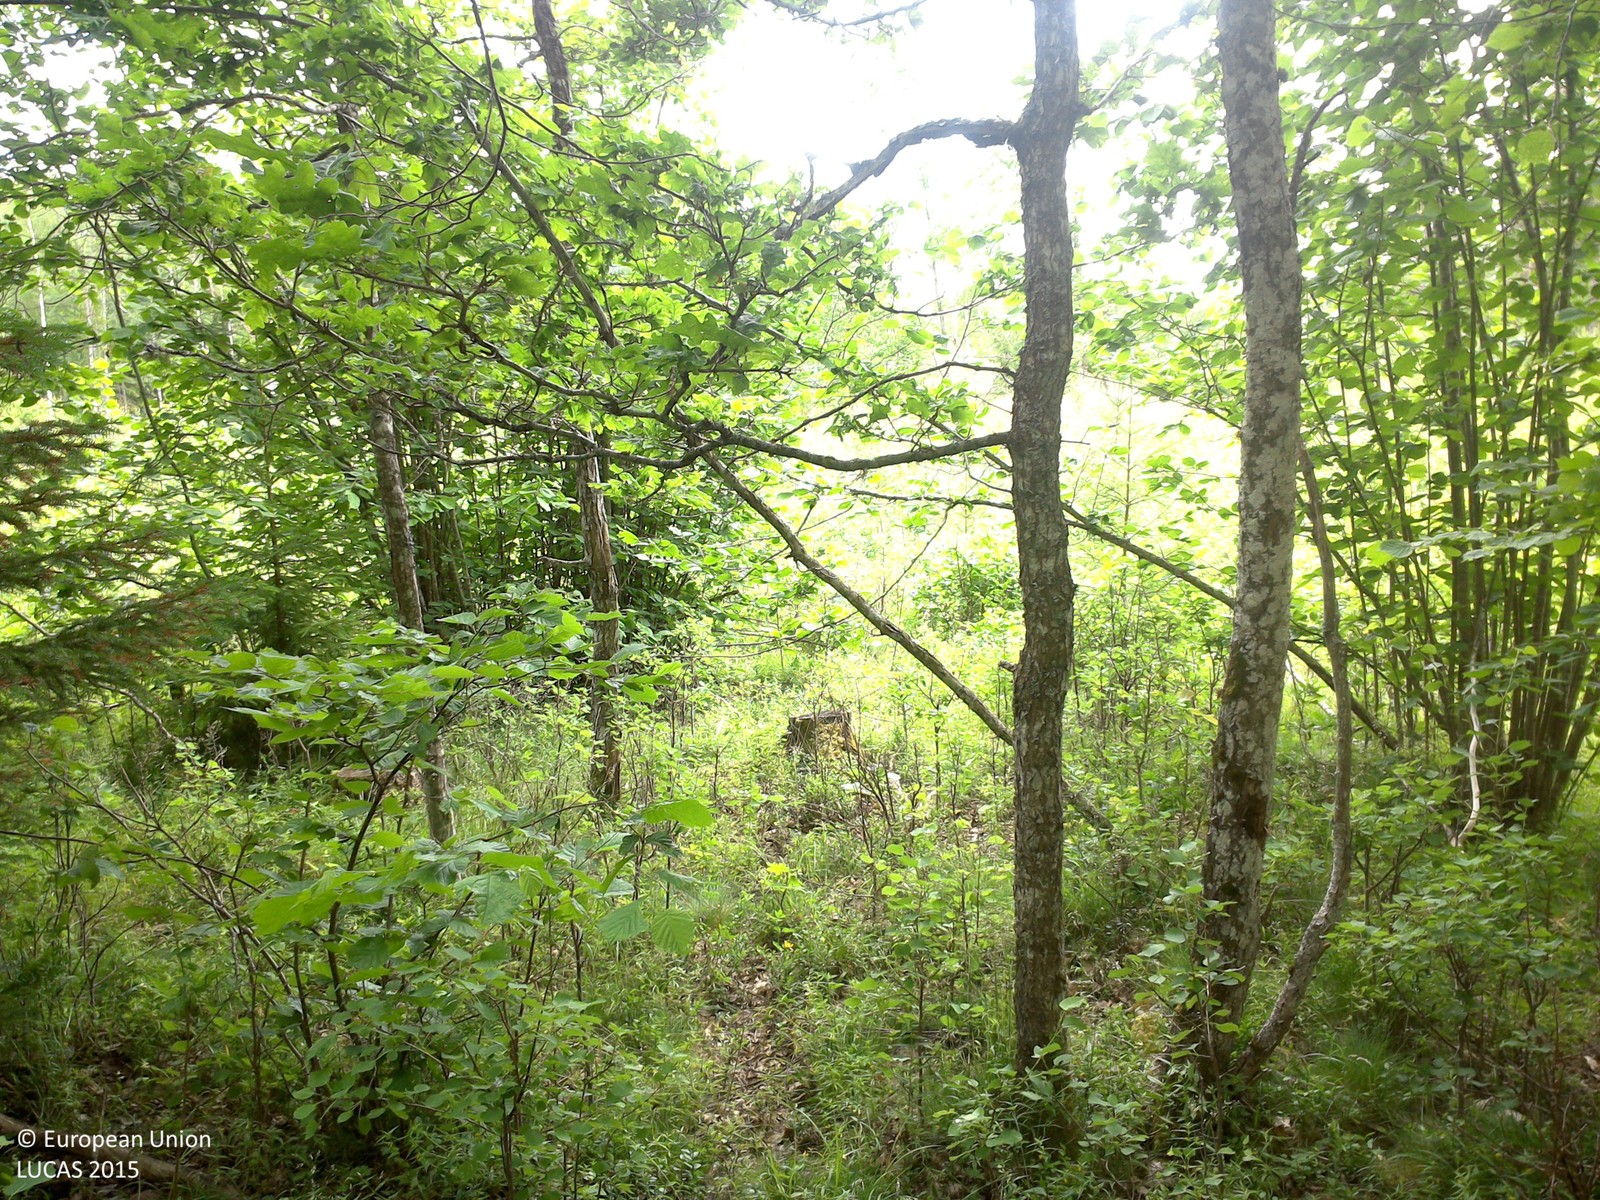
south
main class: Woodland
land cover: Spruce dominated mixed woodland
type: boreal forest
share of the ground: > 75 %
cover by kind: coniferous forest trees 60 %, broadleaved forest trees 30 %, herbaceous plants 10 %
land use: Forestry
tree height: > 5 m
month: June
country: SE
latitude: 58.2113
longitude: 15.5946
